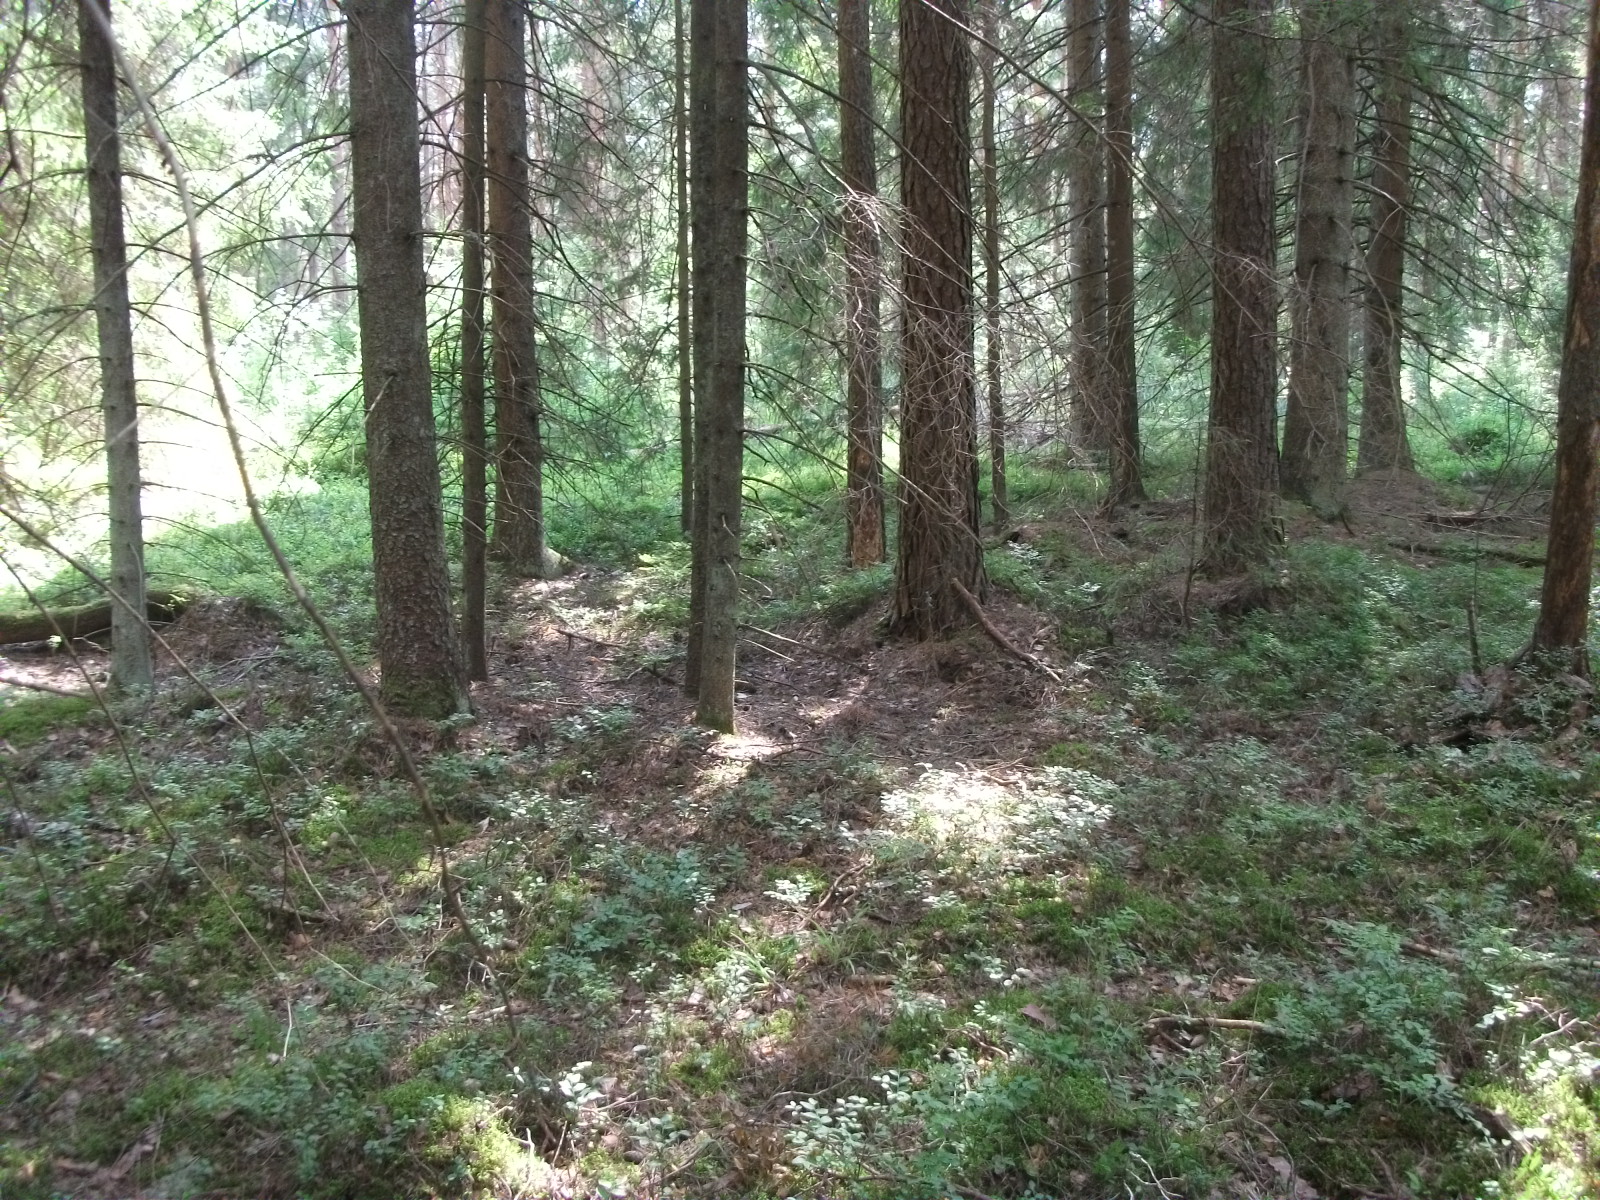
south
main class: Woodland
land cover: Other coniferous woodland
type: hemiboreal forest and nemoral coniferous forest and mixed broadleaved-coniferous forest
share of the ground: > 75 %
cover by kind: coniferous forest trees 80 %, shrubs 5 %, herbaceous plants 5 %, lichens and mosses 5 %, unconsolidated bare surface 5 %
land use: Forestry
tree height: > 5 m
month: August
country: LV
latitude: 56.8010
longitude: 26.5055
